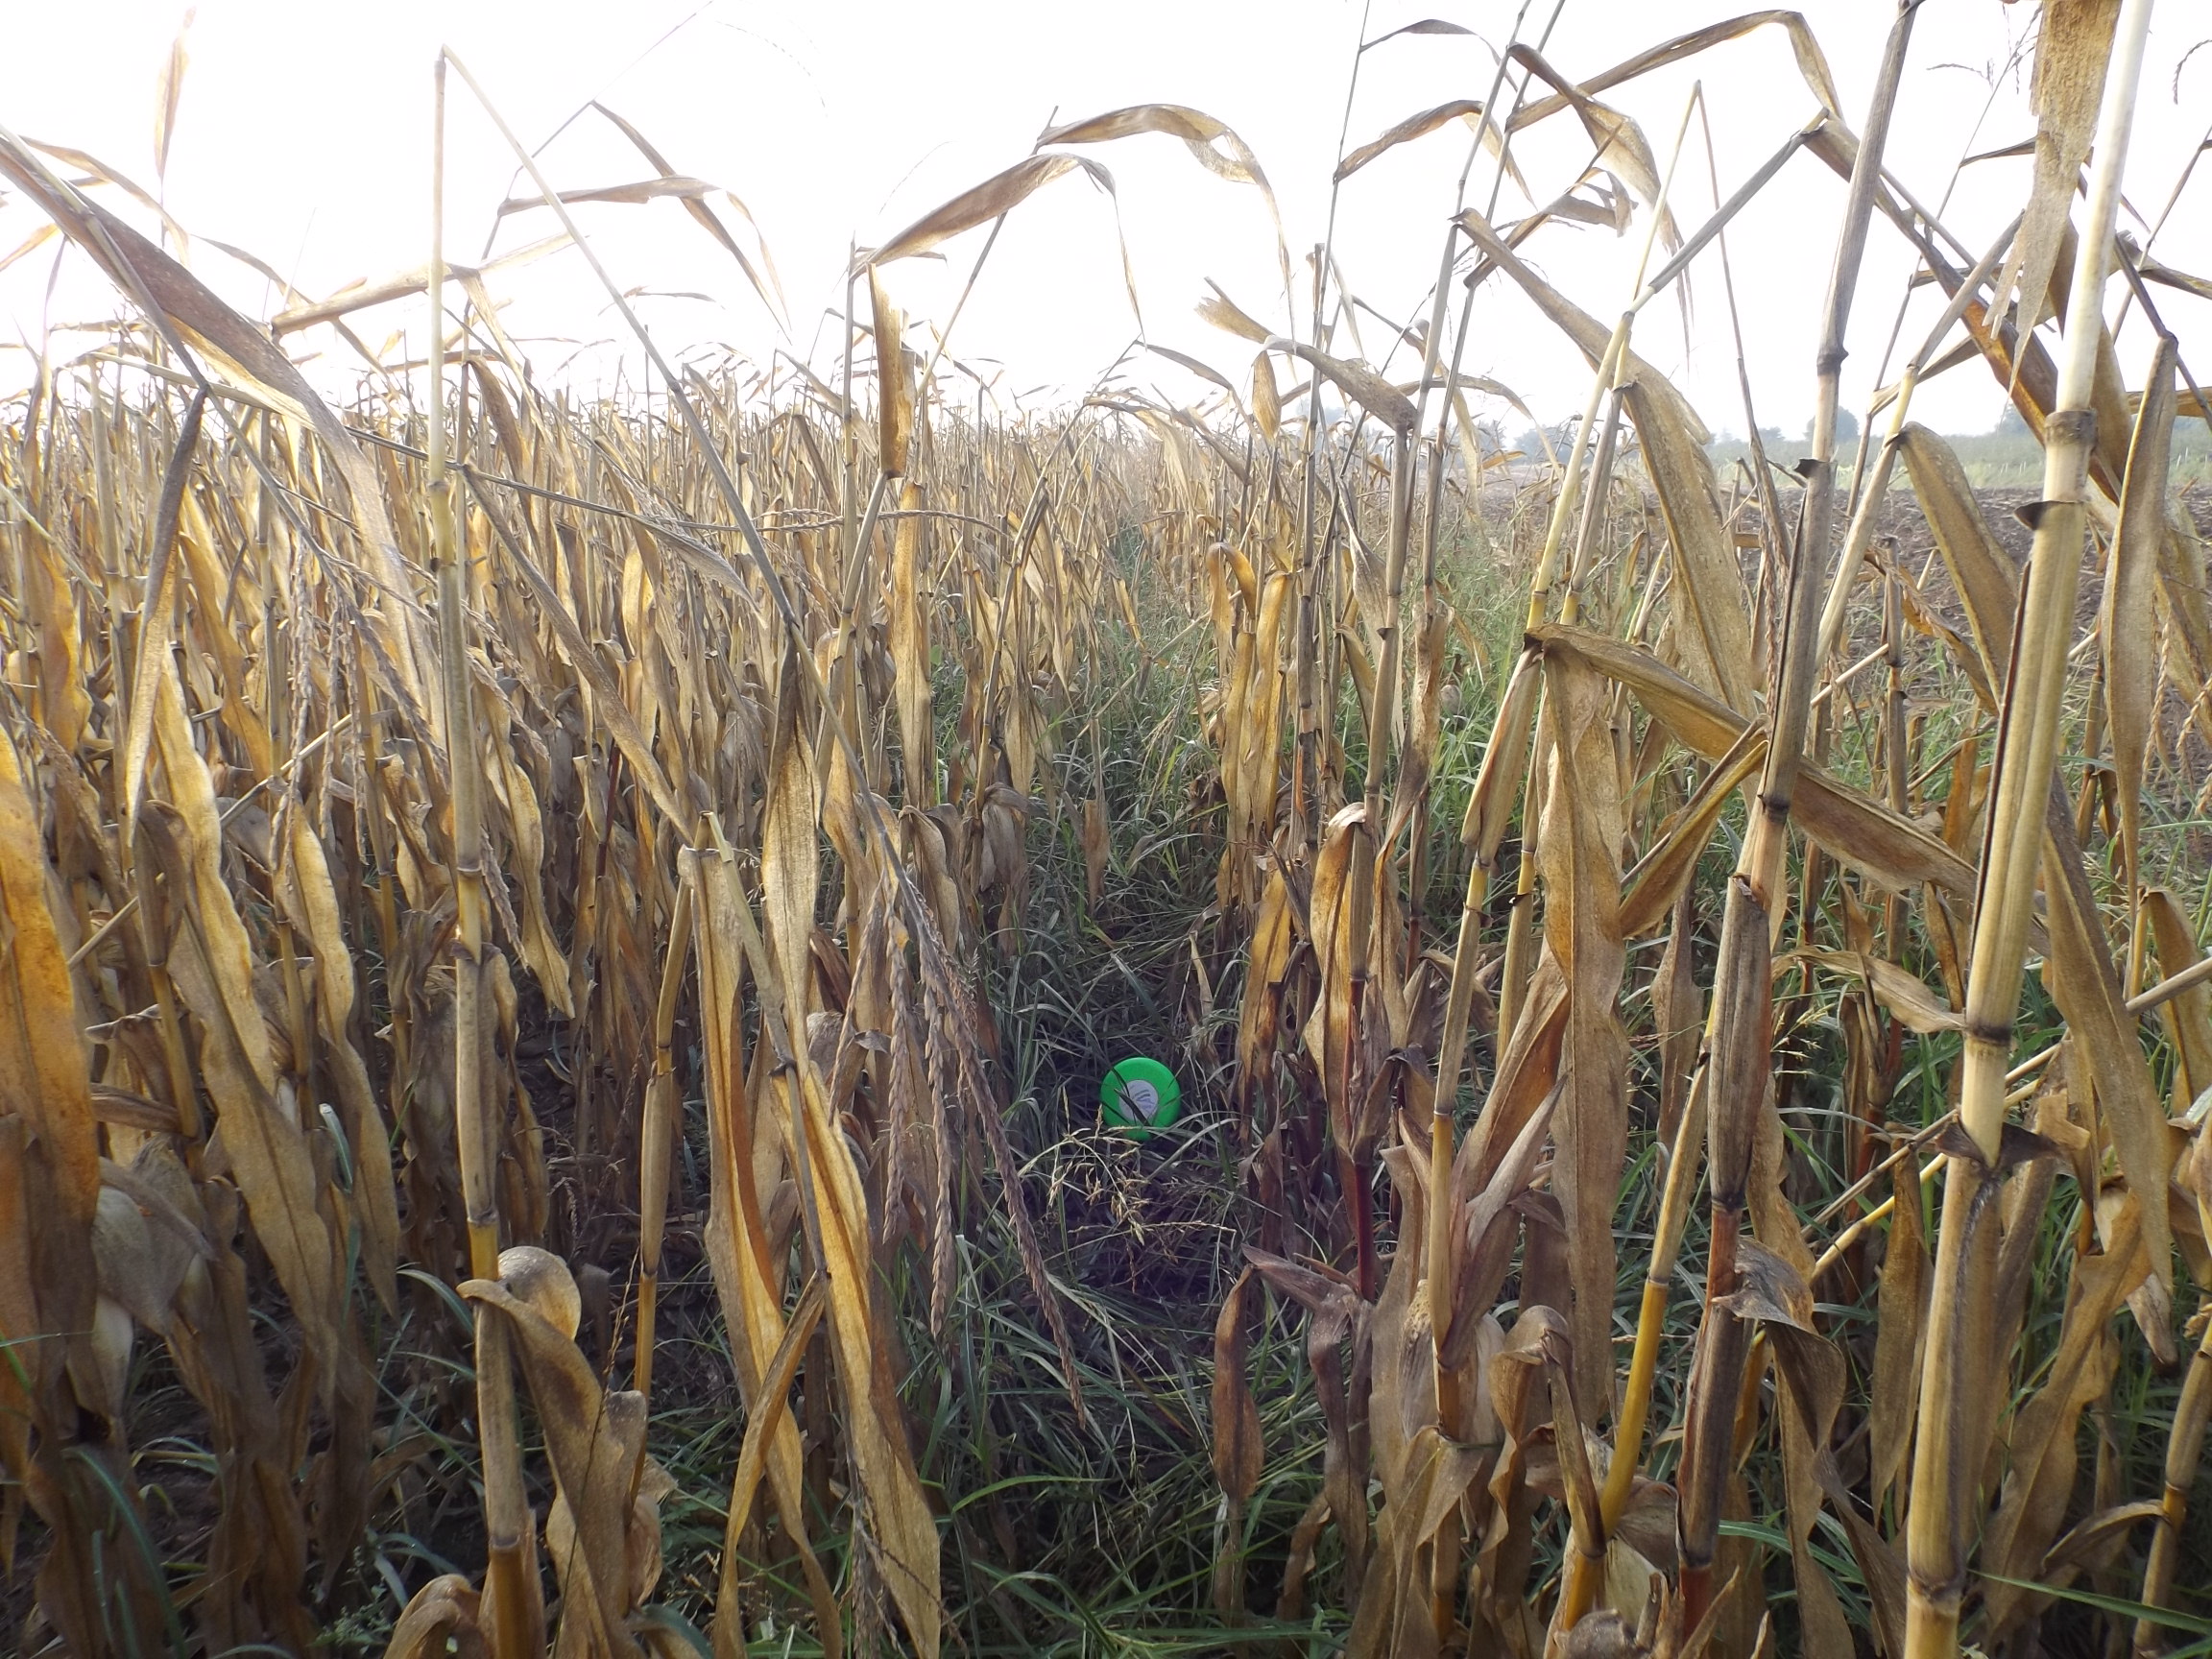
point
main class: Cropland
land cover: Maize
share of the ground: > 75 %
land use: Agriculture (excluding fallow land and kitchen gardens)
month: September
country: BG
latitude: 44.0227
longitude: 26.5420
